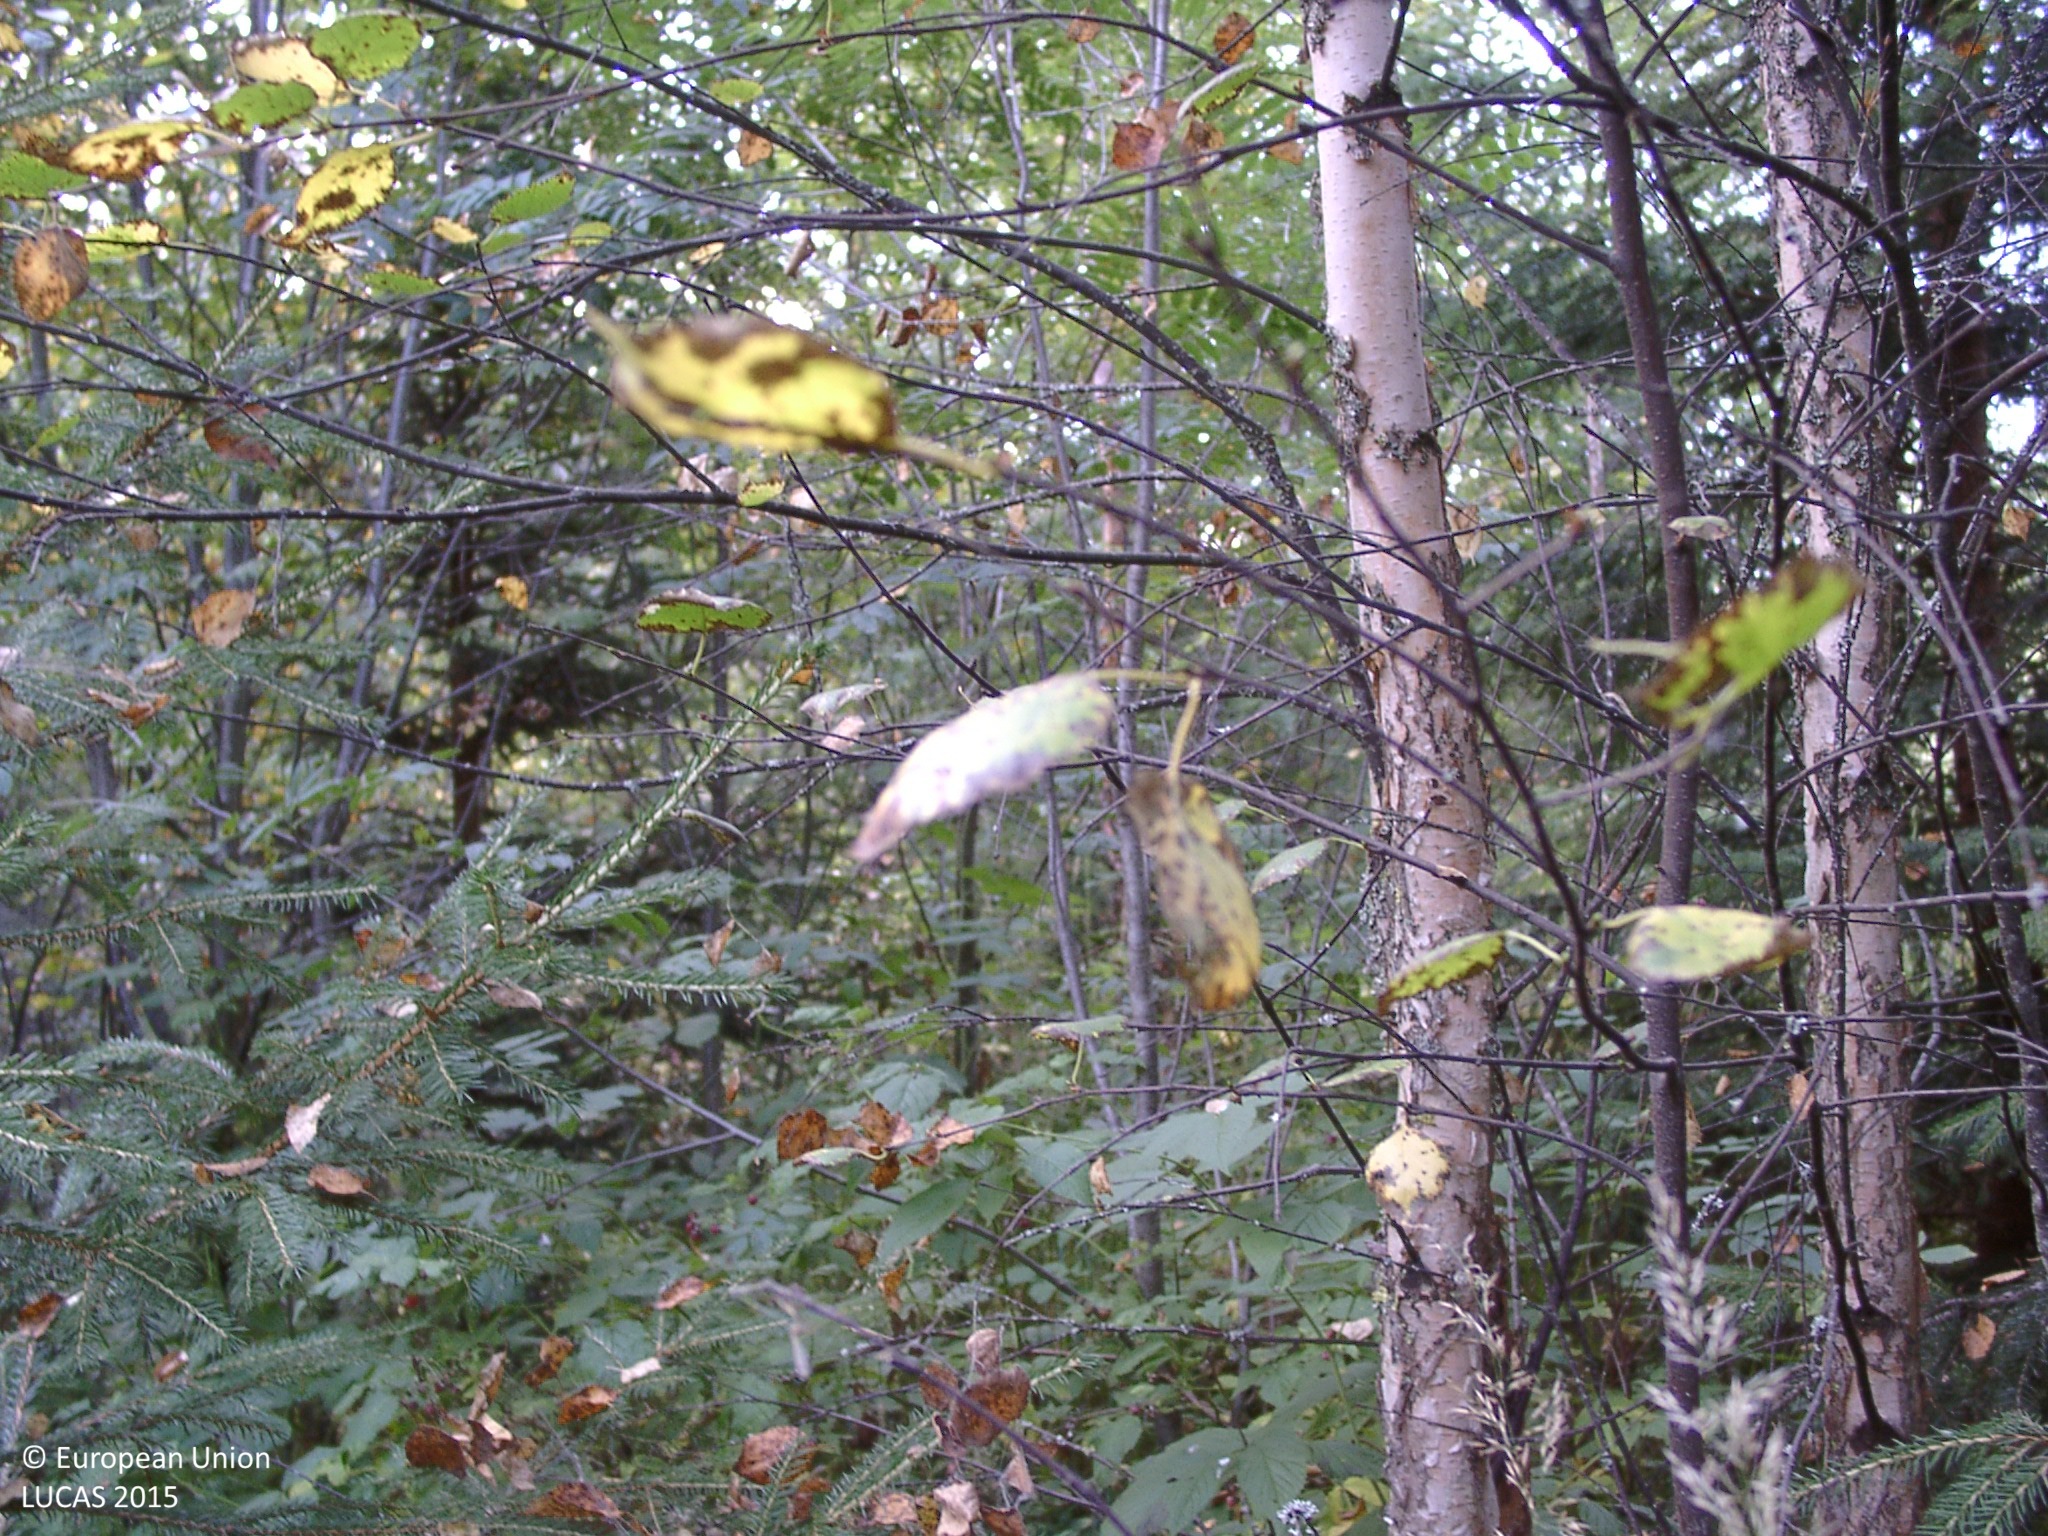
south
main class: Woodland
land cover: Broadleaved woodland
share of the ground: 50 - 75 %
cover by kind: broadleaved forest trees 55 %, herbaceous plants 20 %, shrubs 15 %, coniferous forest trees 10 %
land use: Forestry
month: August
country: FI
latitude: 61.8057
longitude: 25.1171
